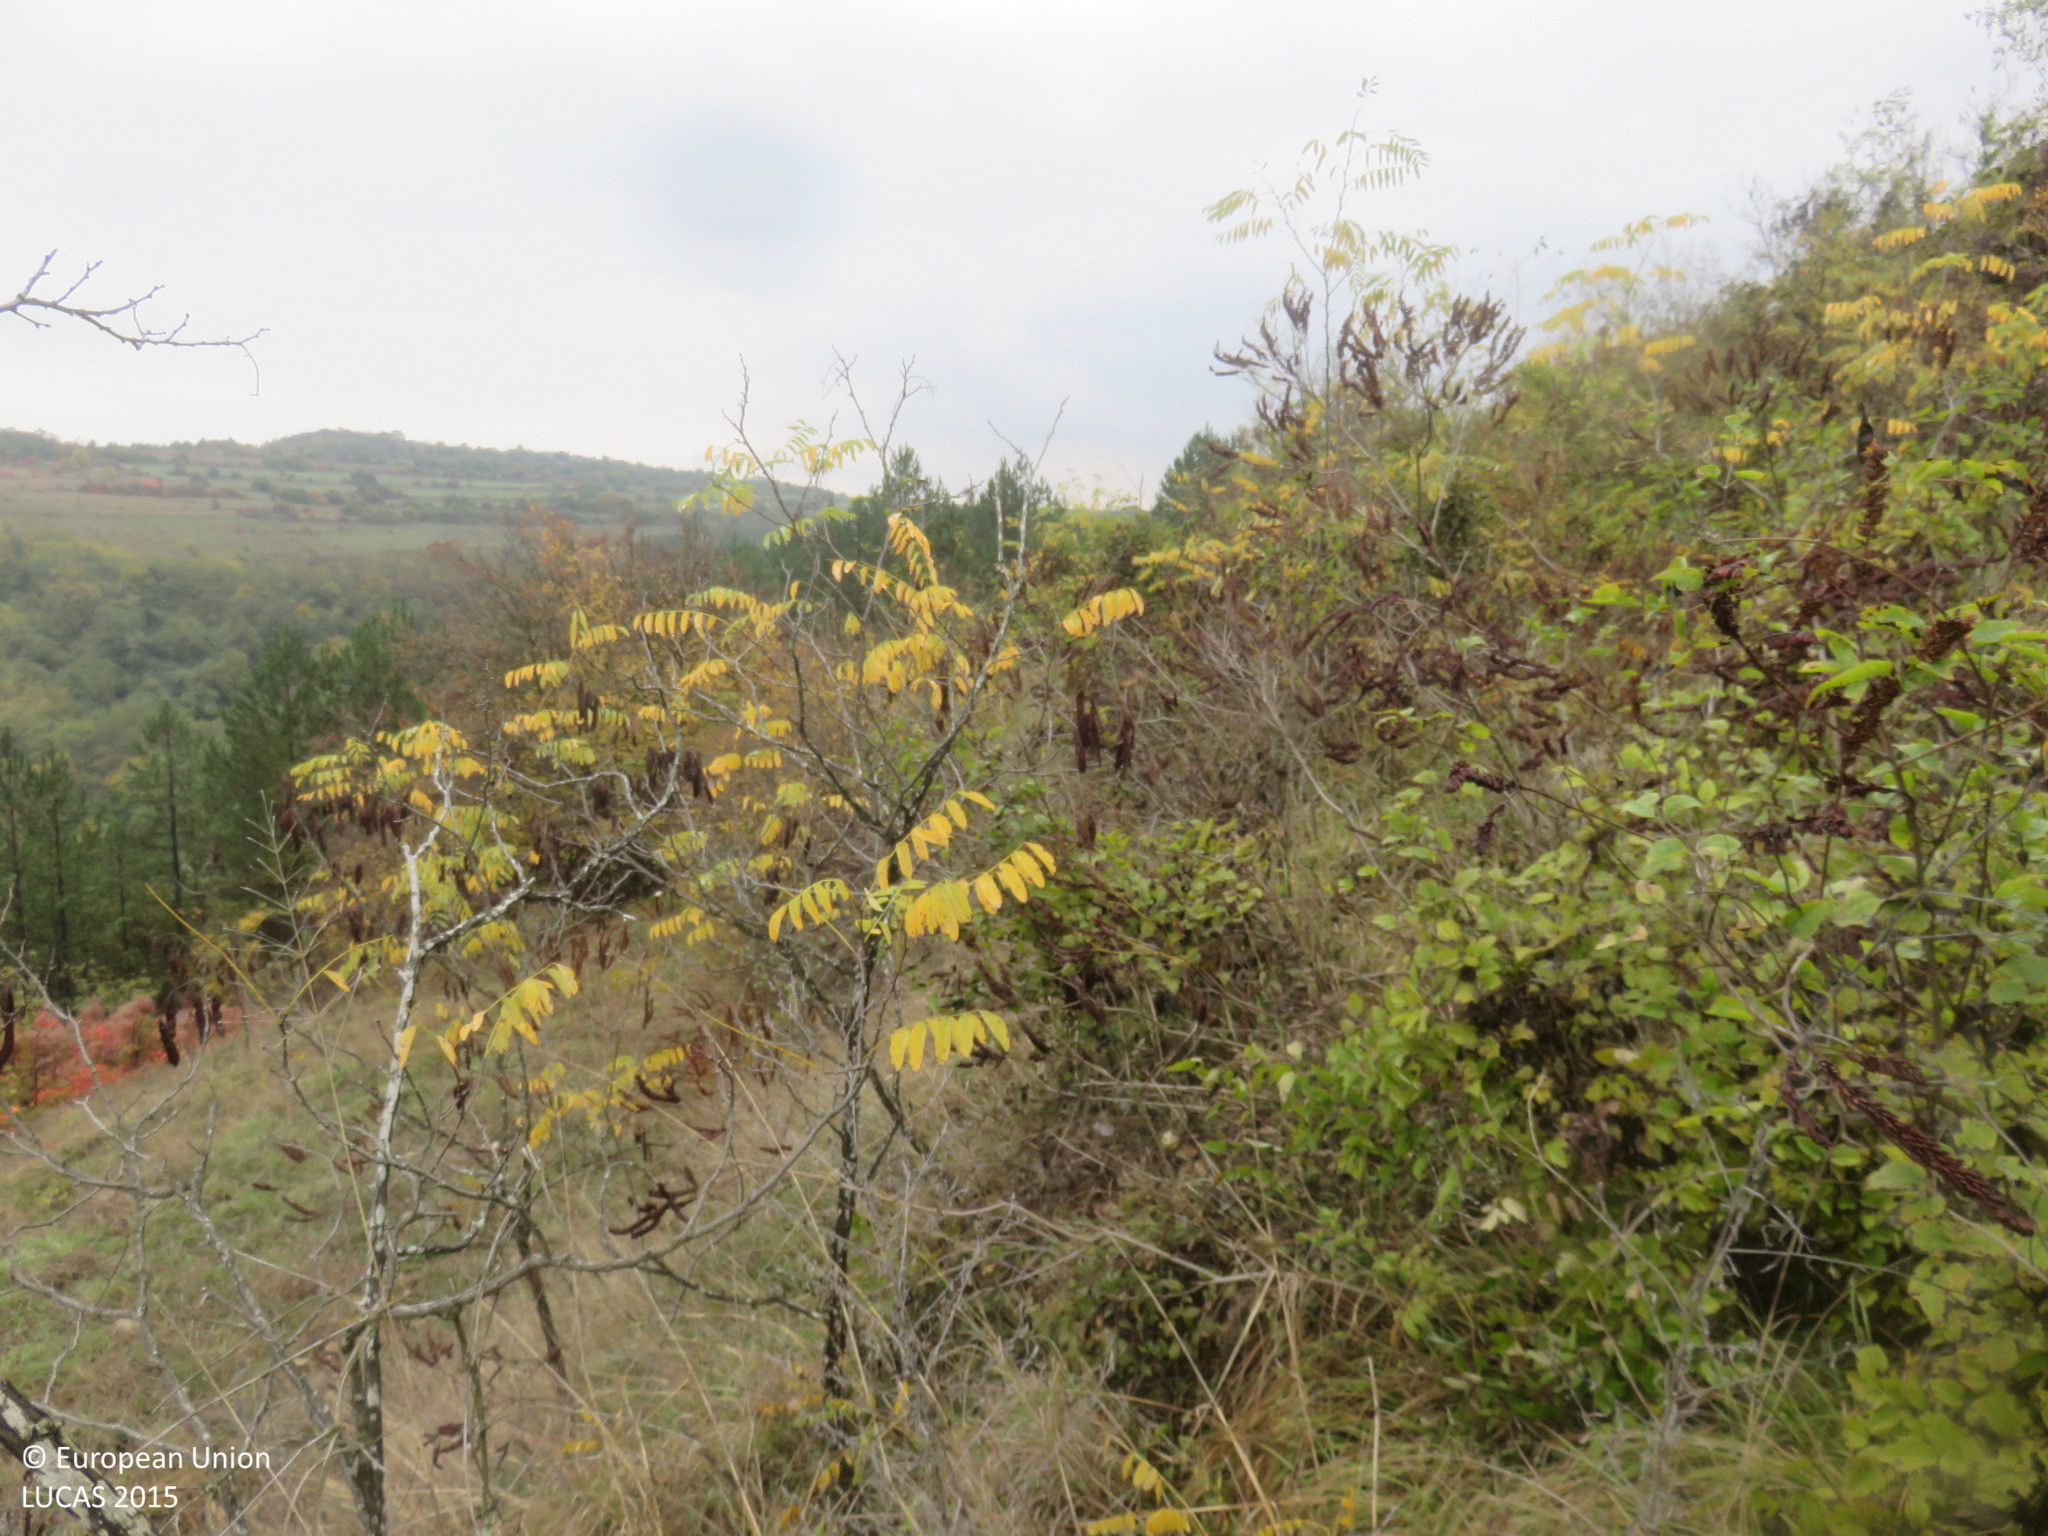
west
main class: Woodland
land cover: Broadleaved woodland
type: mesophytic deciduous forest
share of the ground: > 75 %
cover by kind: broadleaved forest trees 95 %, shrubs 5 %
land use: Semi-natural and natural areas not in use
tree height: > 5 m
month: October
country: BG
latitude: 43.0819
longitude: 25.0406
